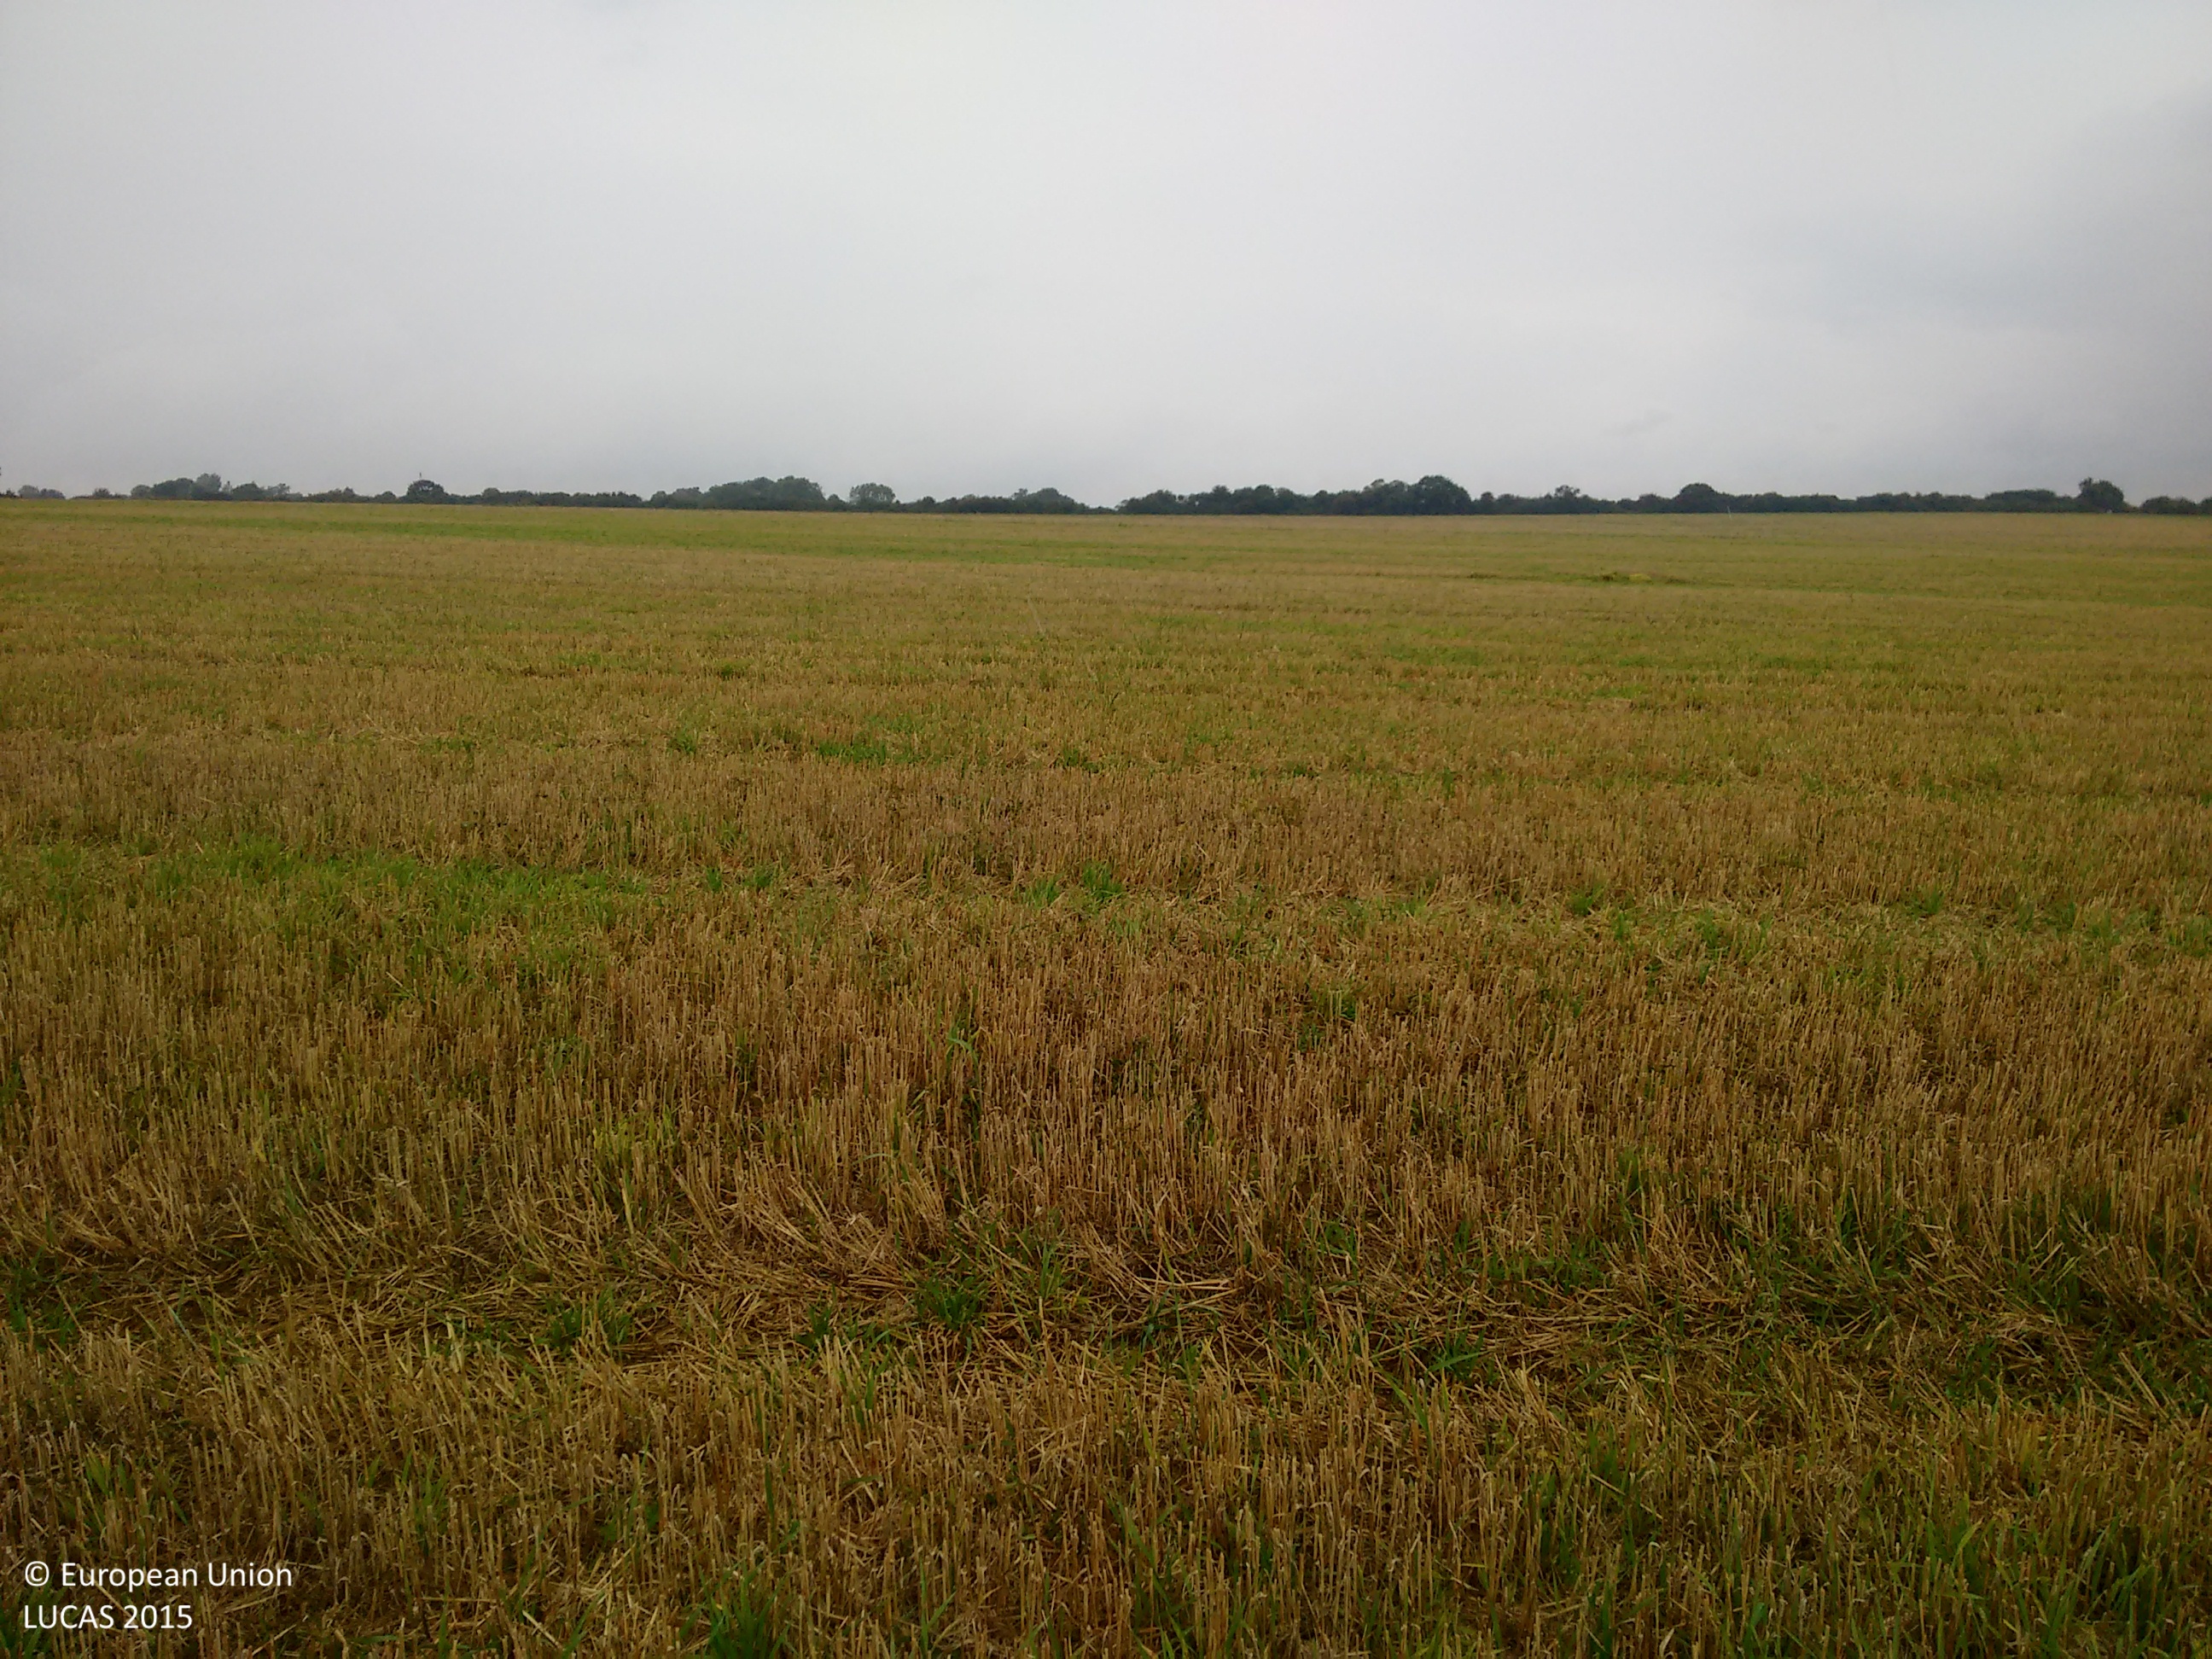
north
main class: Cropland
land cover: Barley
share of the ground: > 75 %
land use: Agriculture (excluding fallow land and kitchen gardens)
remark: Harvested field
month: September
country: GB
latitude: 51.9428
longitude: 0.2963
